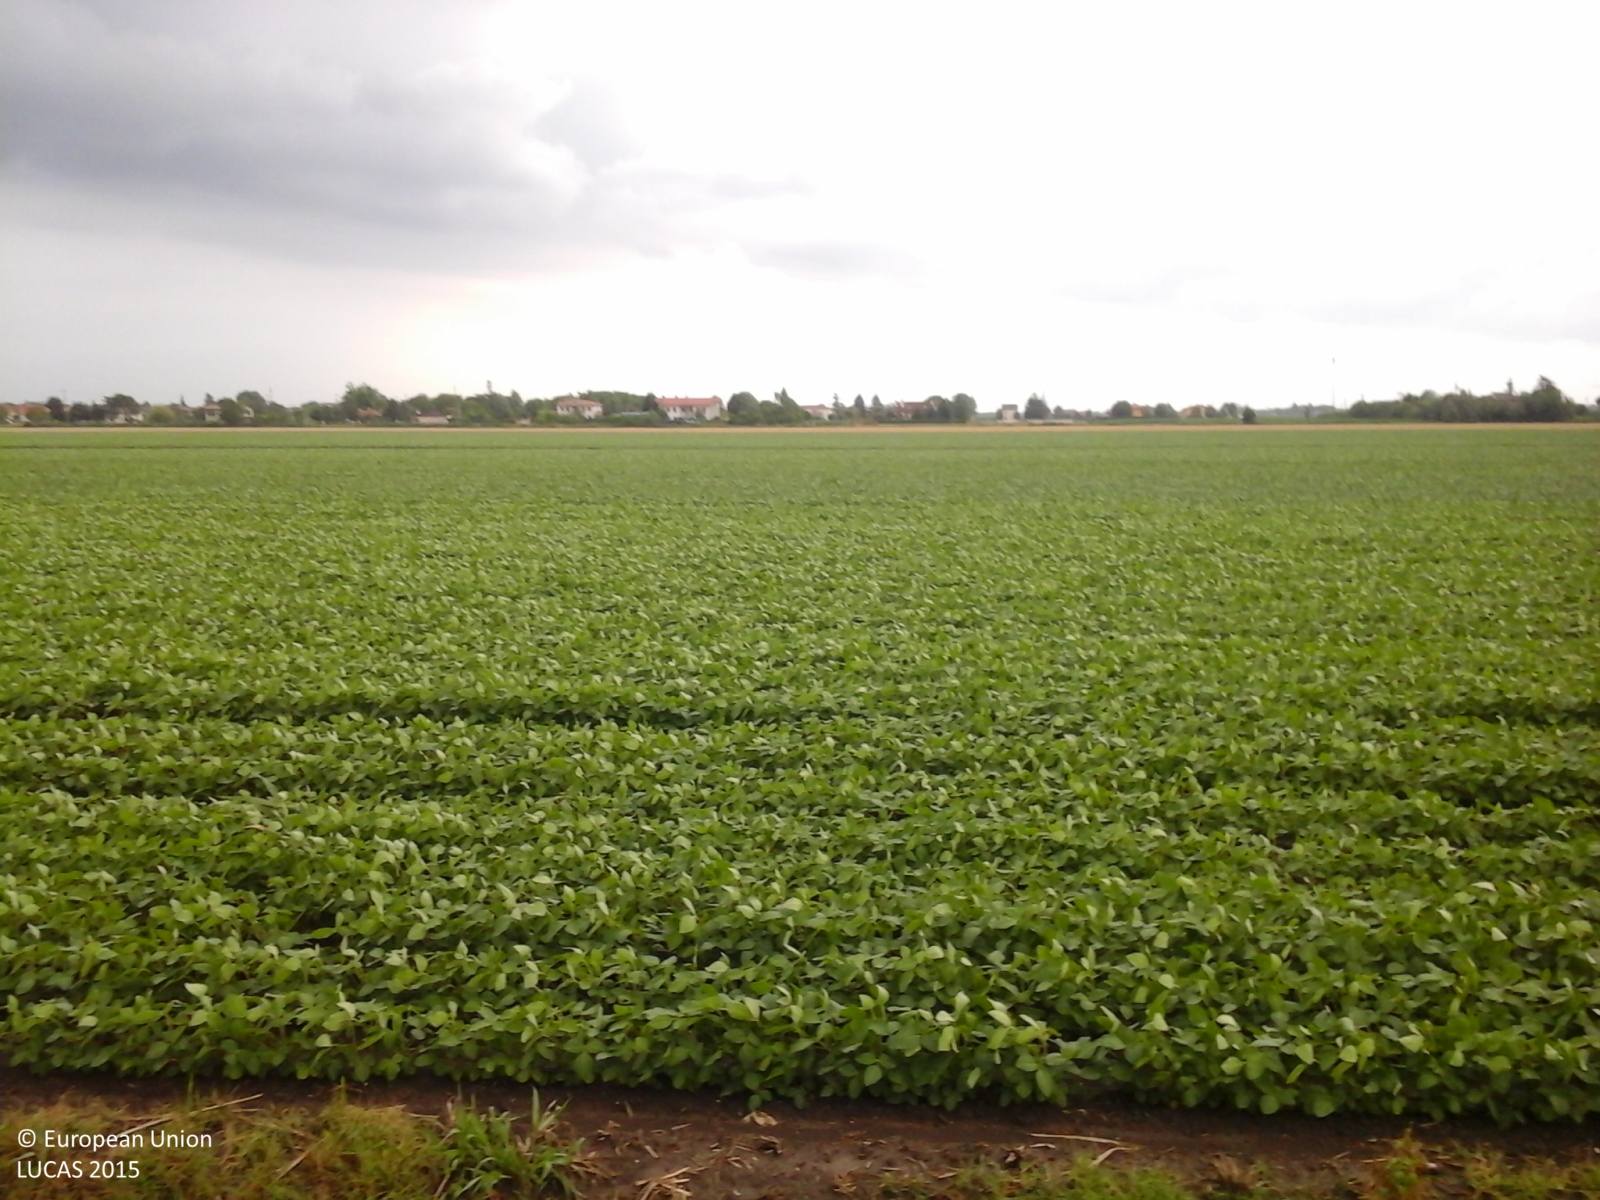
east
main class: Cropland
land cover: Soya
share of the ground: > 75 %
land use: Agriculture (excluding fallow land and kitchen gardens)
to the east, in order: Soya; Ditches and canals; Common wheat; Ditches and canals; Soya; Ditches and canals; Managed hedges; Electric lines; Soya
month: June
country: IT
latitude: 45.6328
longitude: 12.6772
